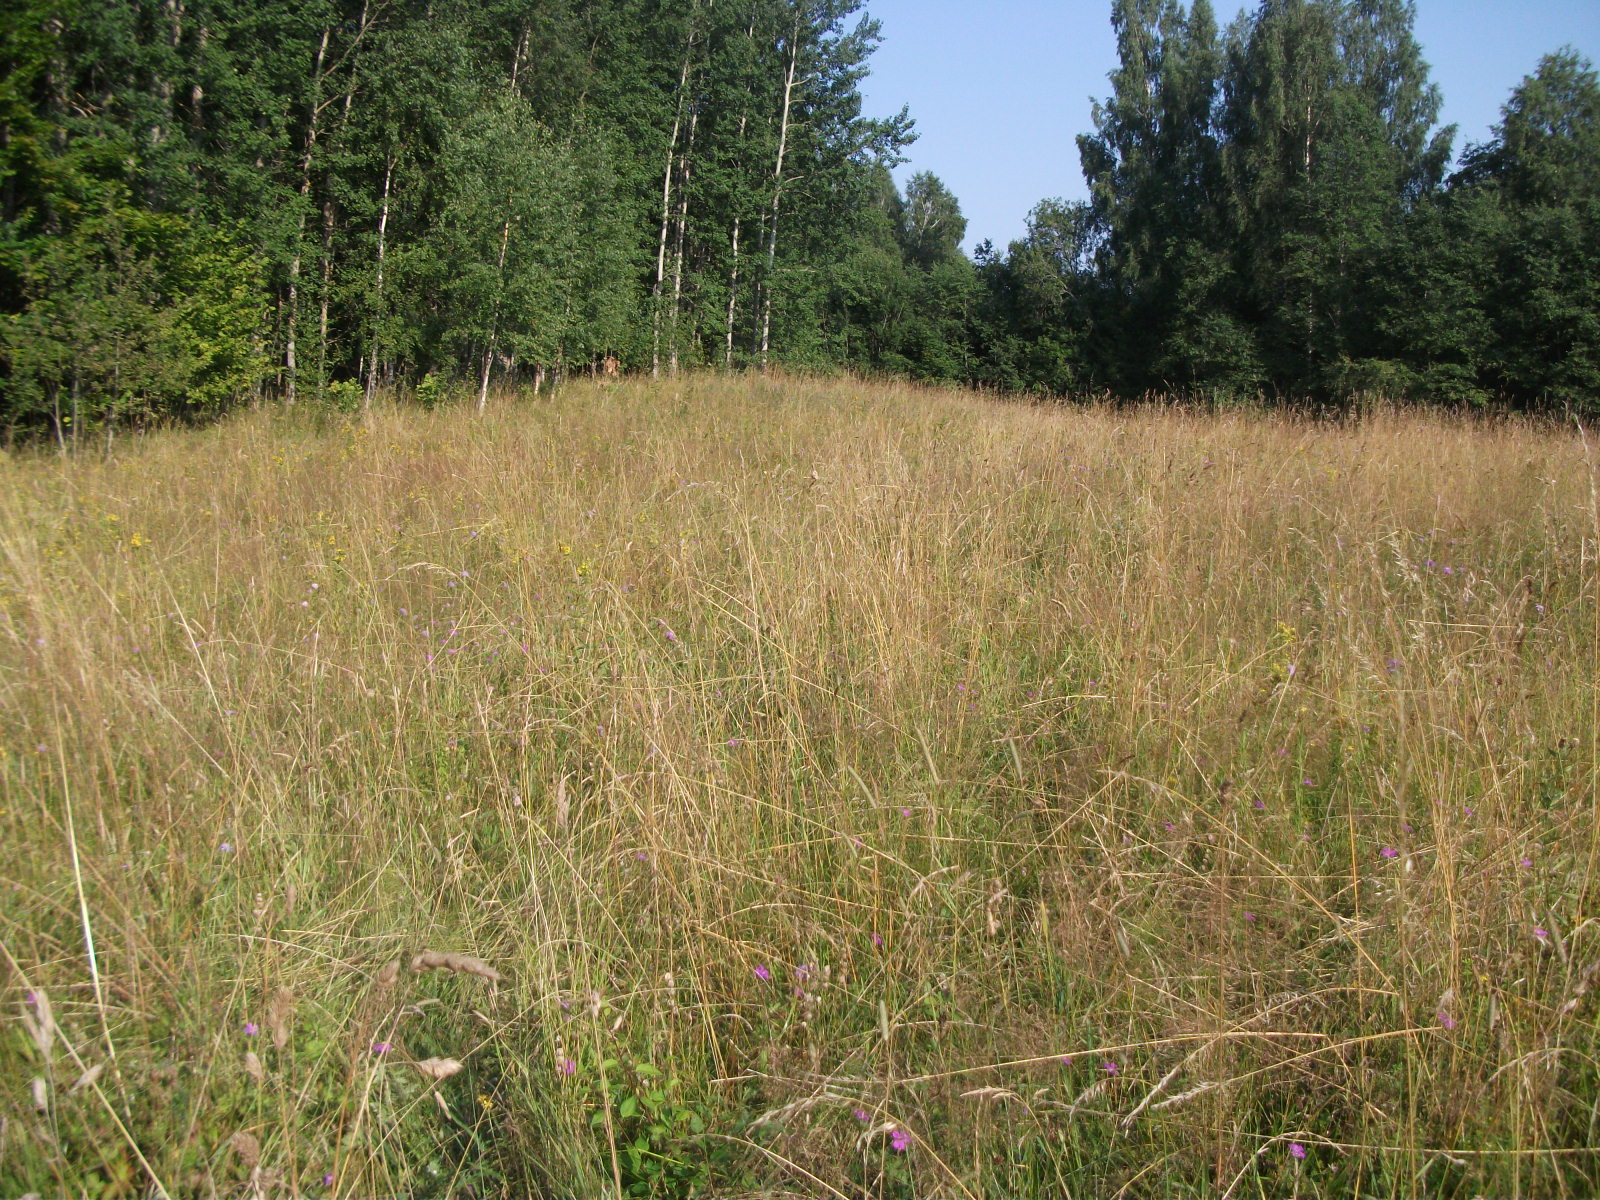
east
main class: Grassland
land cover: Grassland without tree/shrub cover
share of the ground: > 75 %
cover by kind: herbaceous plants 100 %
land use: Agriculture (excluding fallow land and kitchen gardens)
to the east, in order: Grassland without tree/shrub cover; Broadleaved woodland
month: August
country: LV
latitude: 56.7926
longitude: 25.6933
